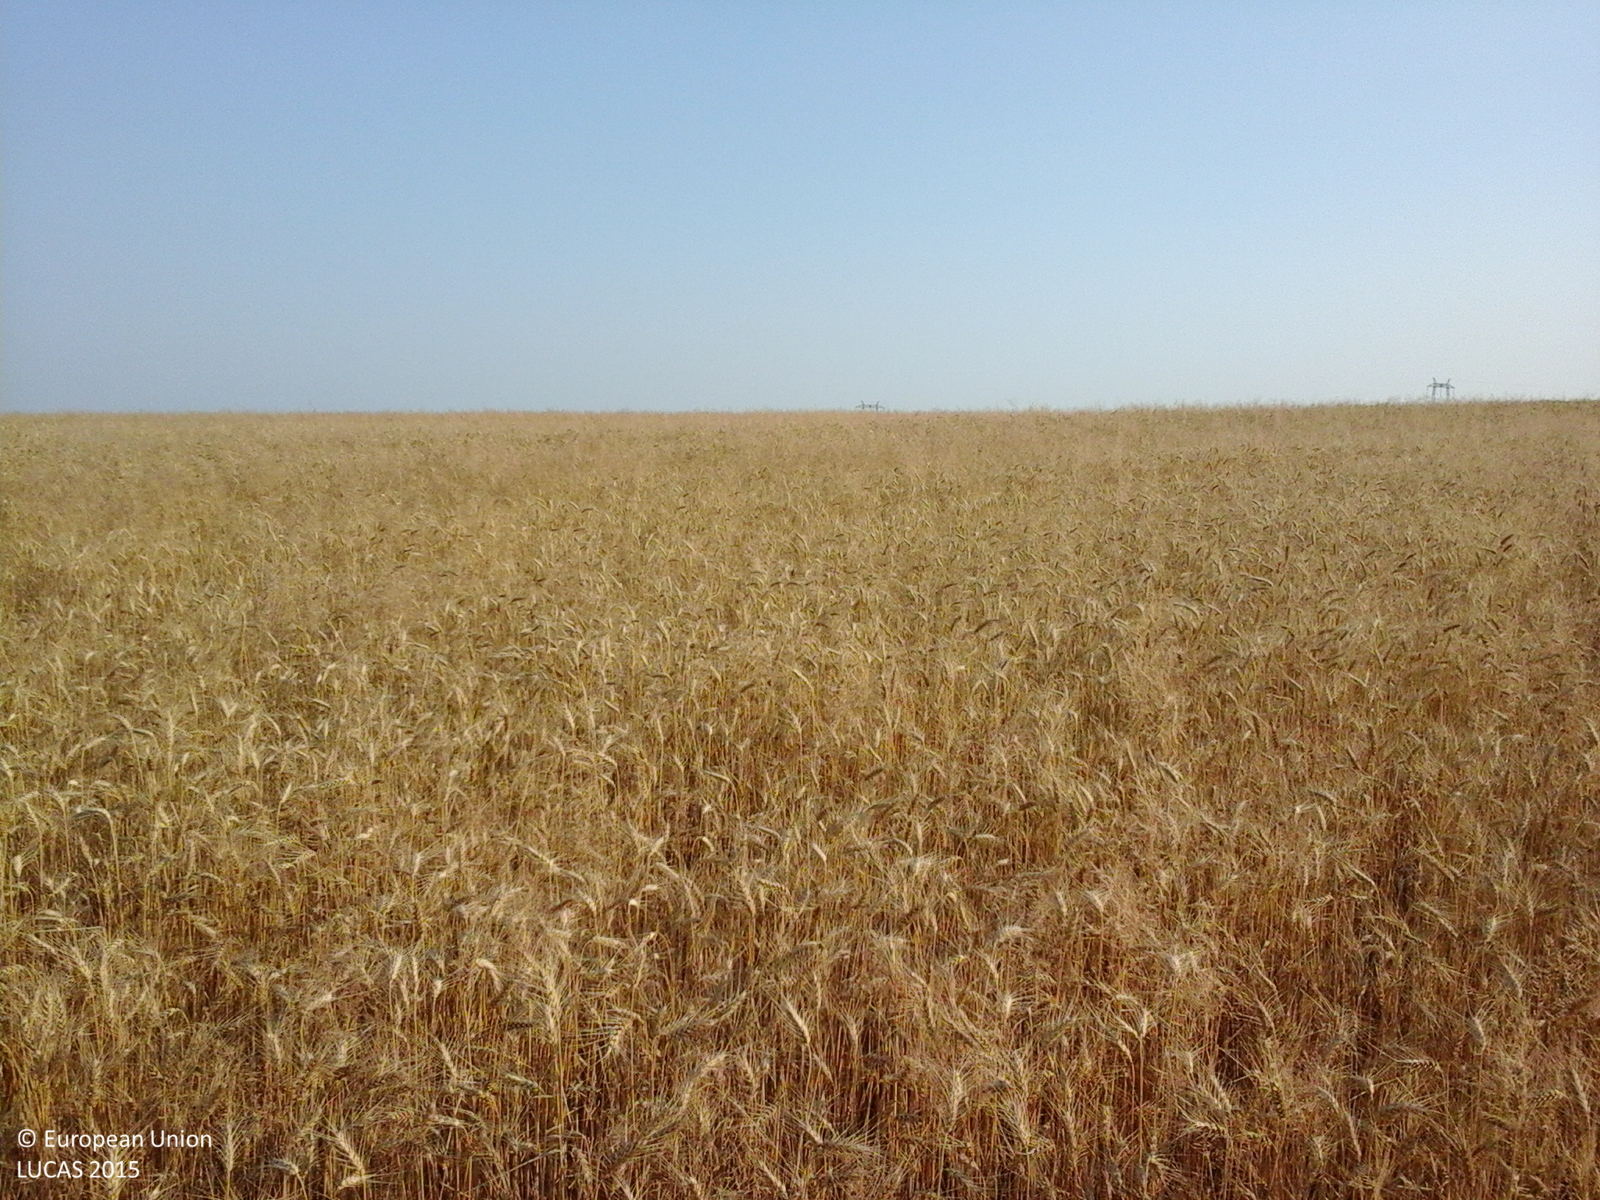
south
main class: Cropland
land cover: Common wheat
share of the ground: > 75 %
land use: Agriculture (excluding fallow land and kitchen gardens)
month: July
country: RO
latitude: 44.6882
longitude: 24.7005
